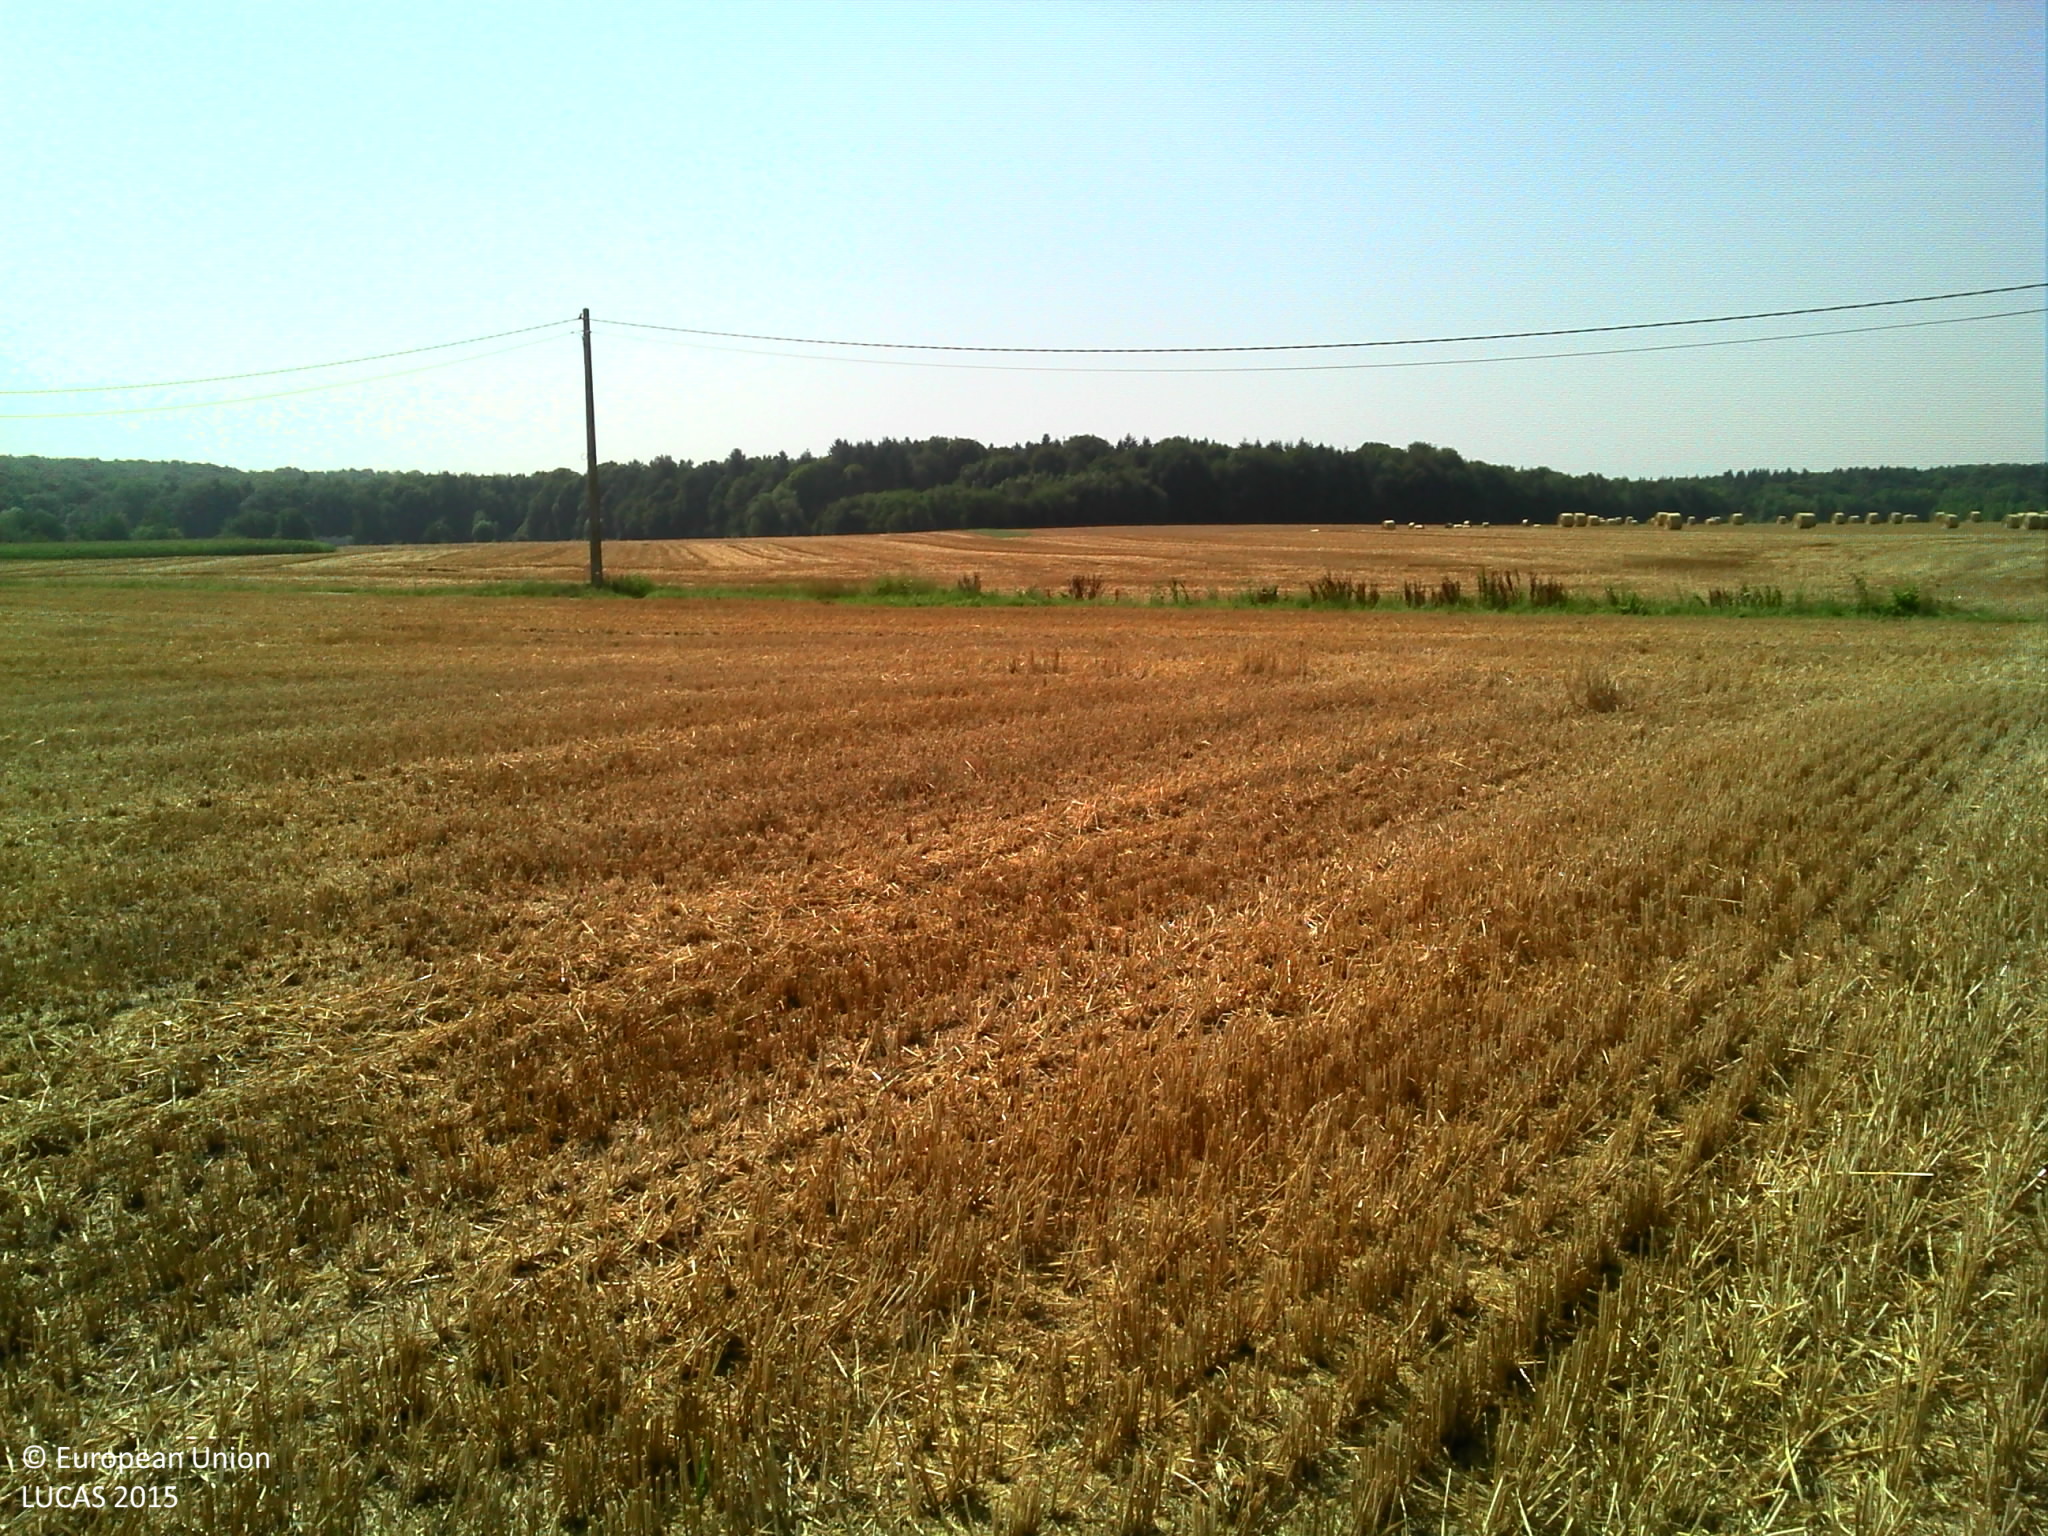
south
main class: Cropland
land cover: Common wheat
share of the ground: < 10 %
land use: Agriculture (excluding fallow land and kitchen gardens)
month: August
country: BE
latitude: 50.6564
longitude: 3.9824
